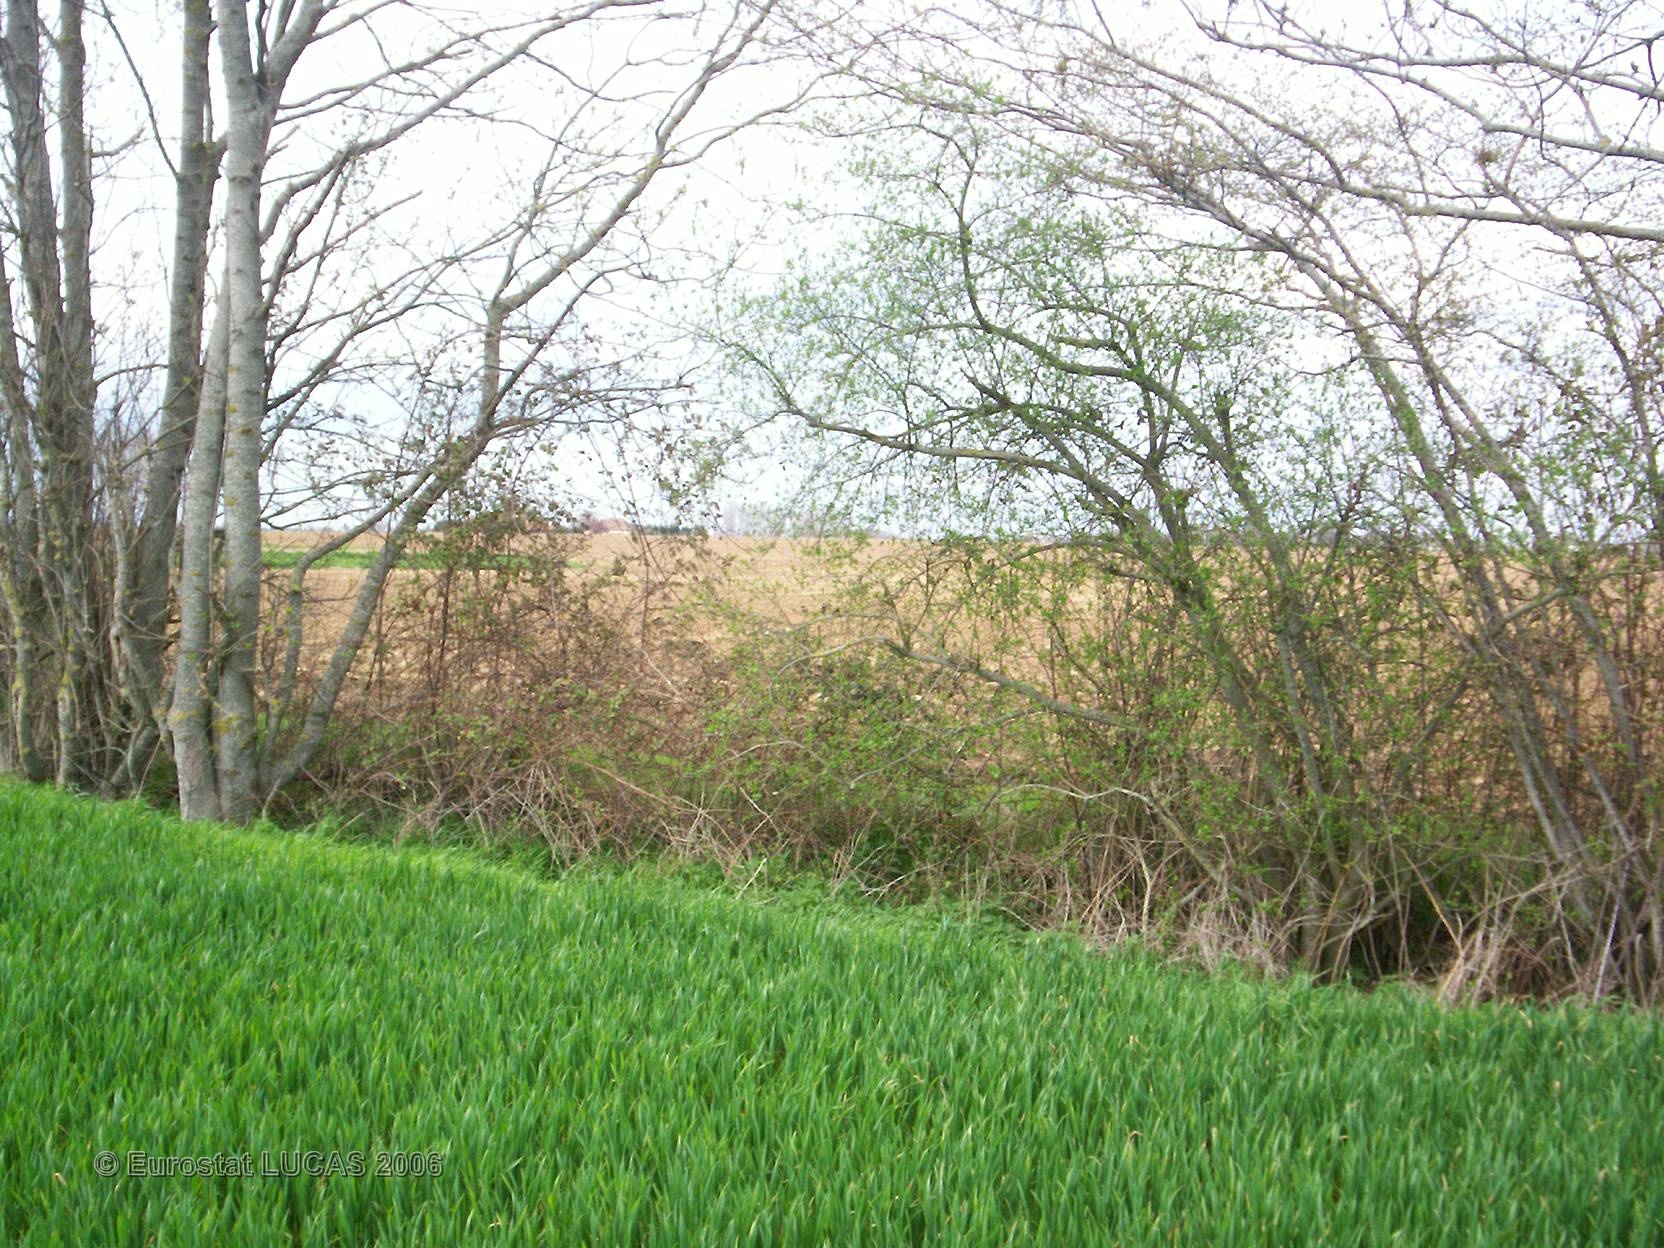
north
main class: Cropland
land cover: Common wheat
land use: Agriculture (excluding fallow land and kitchen gardens)
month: April
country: FR
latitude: 48.2696
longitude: 0.3413
